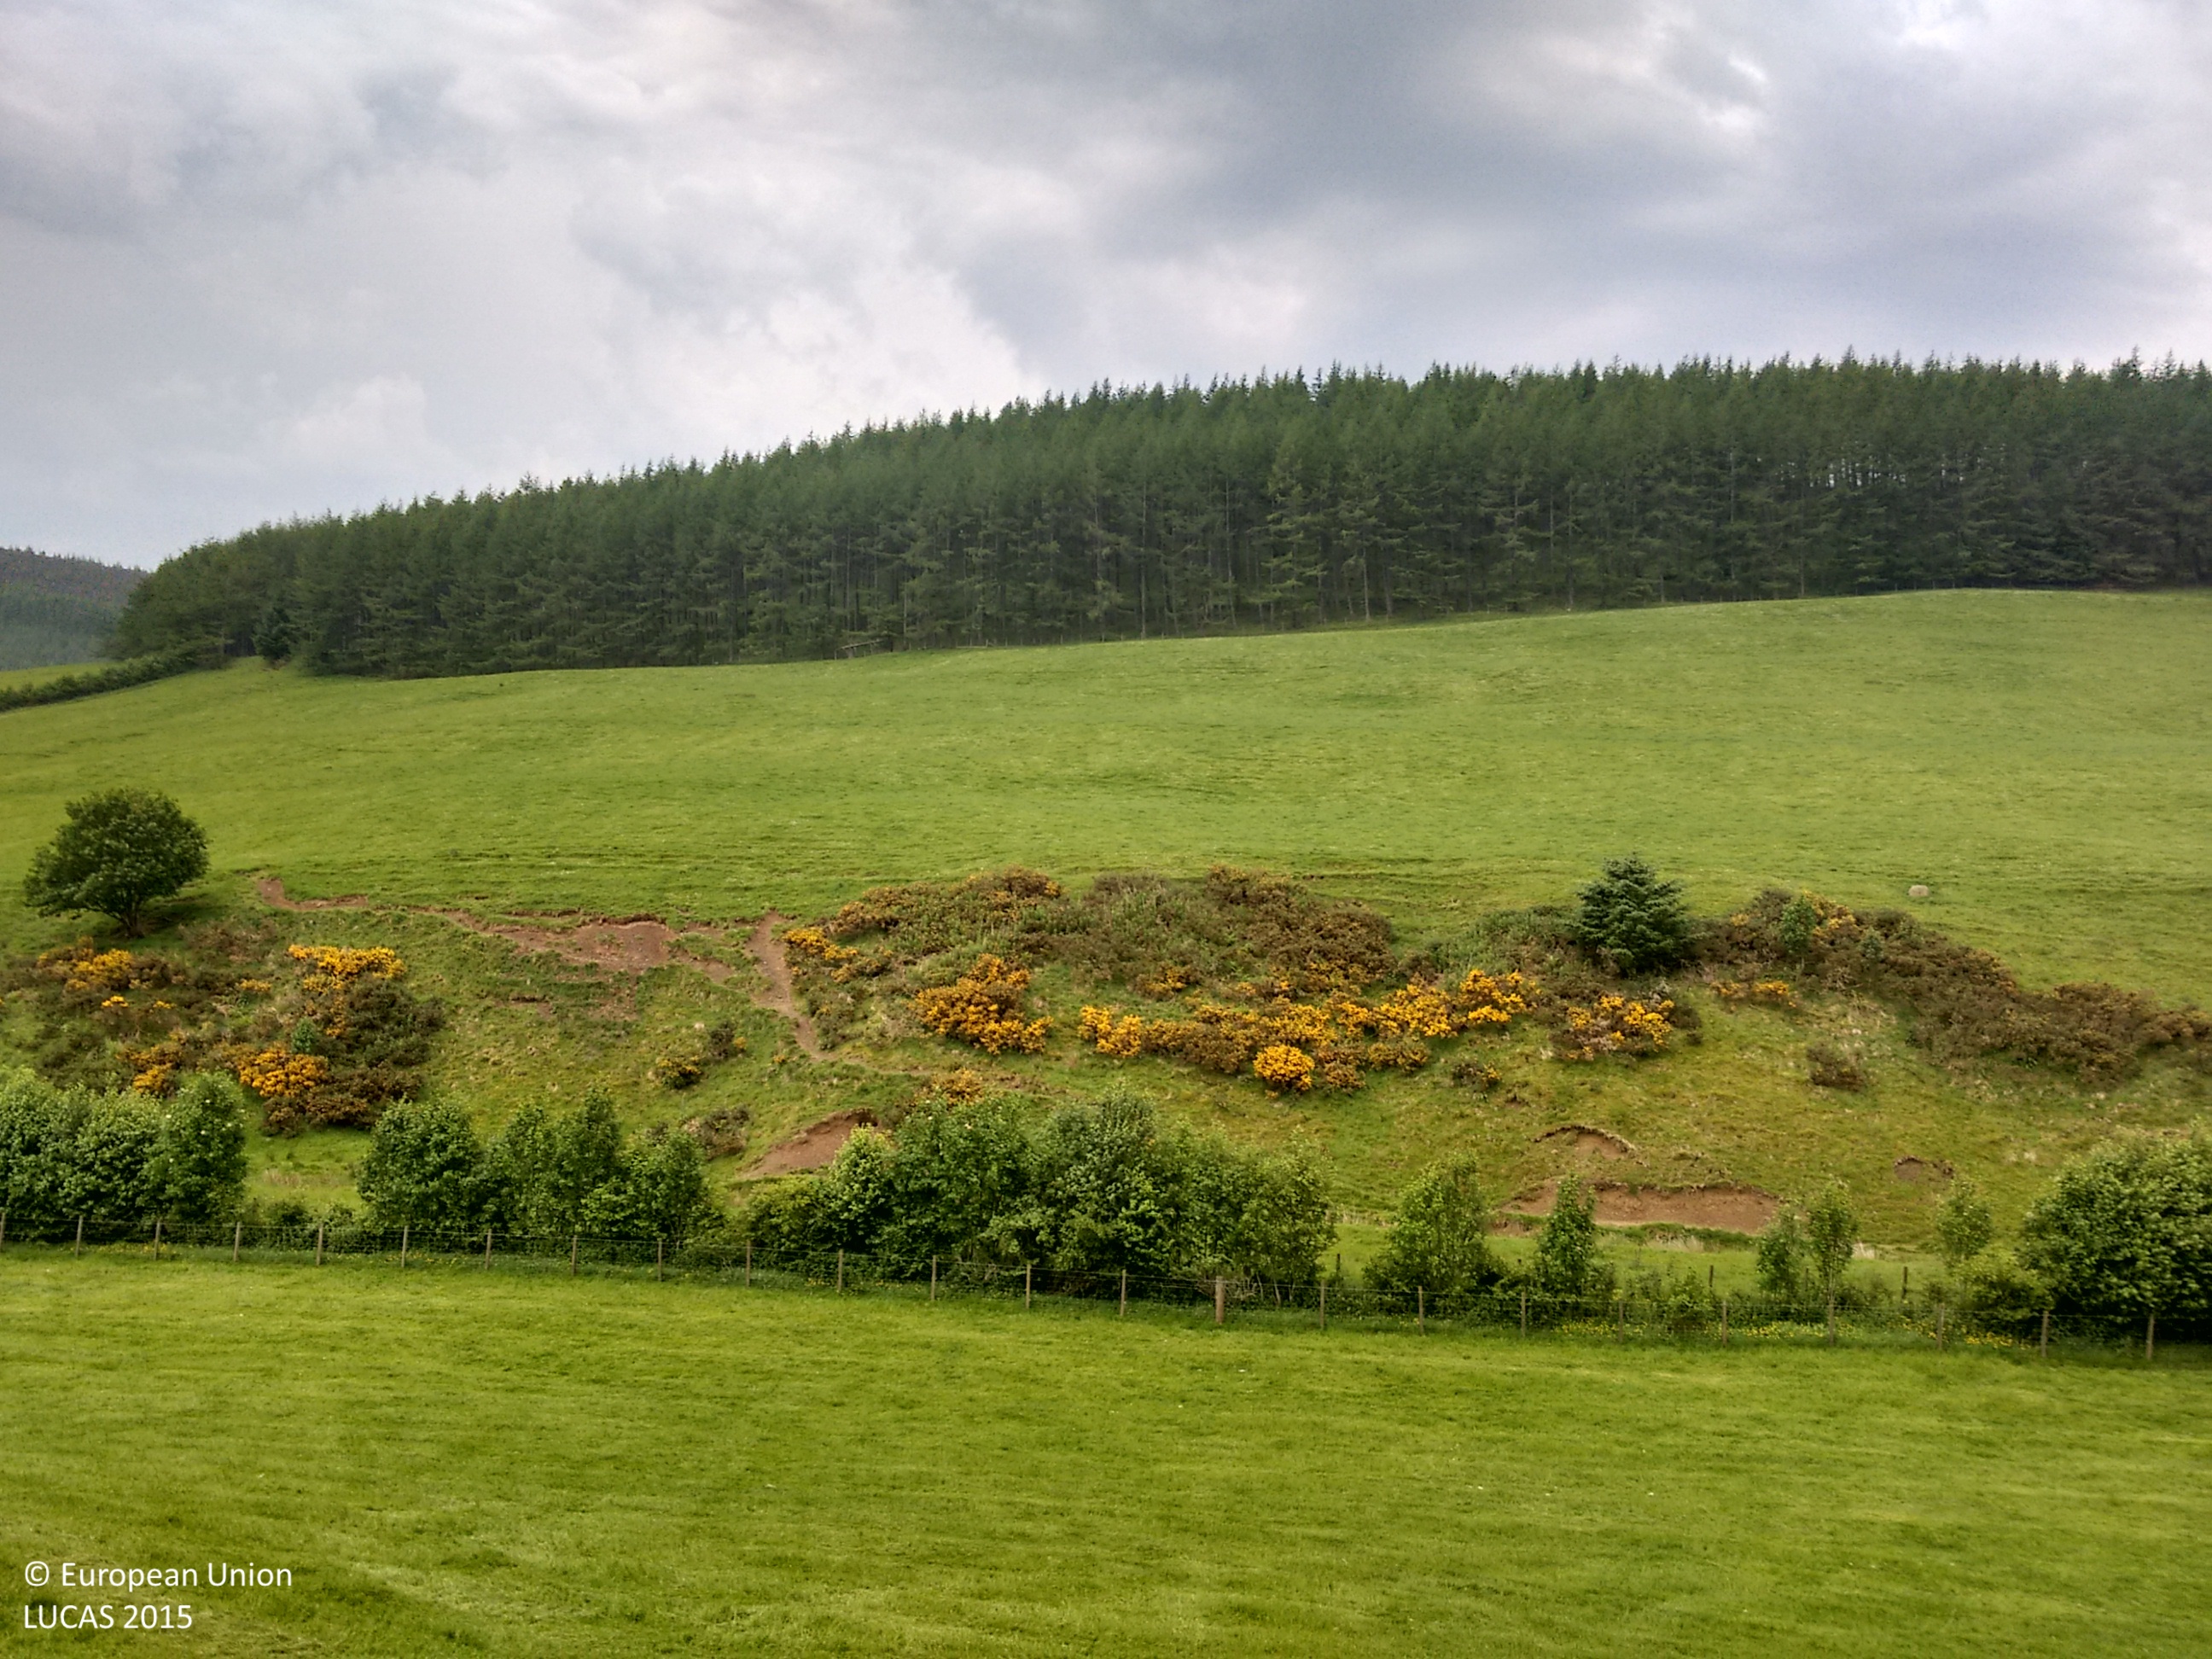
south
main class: Grassland
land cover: Grassland without tree/shrub cover
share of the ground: > 75 %
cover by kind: herbaceous plants 100 %
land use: Agriculture (excluding fallow land and kitchen gardens)
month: July
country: GB
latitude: 57.3804
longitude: -2.8498
